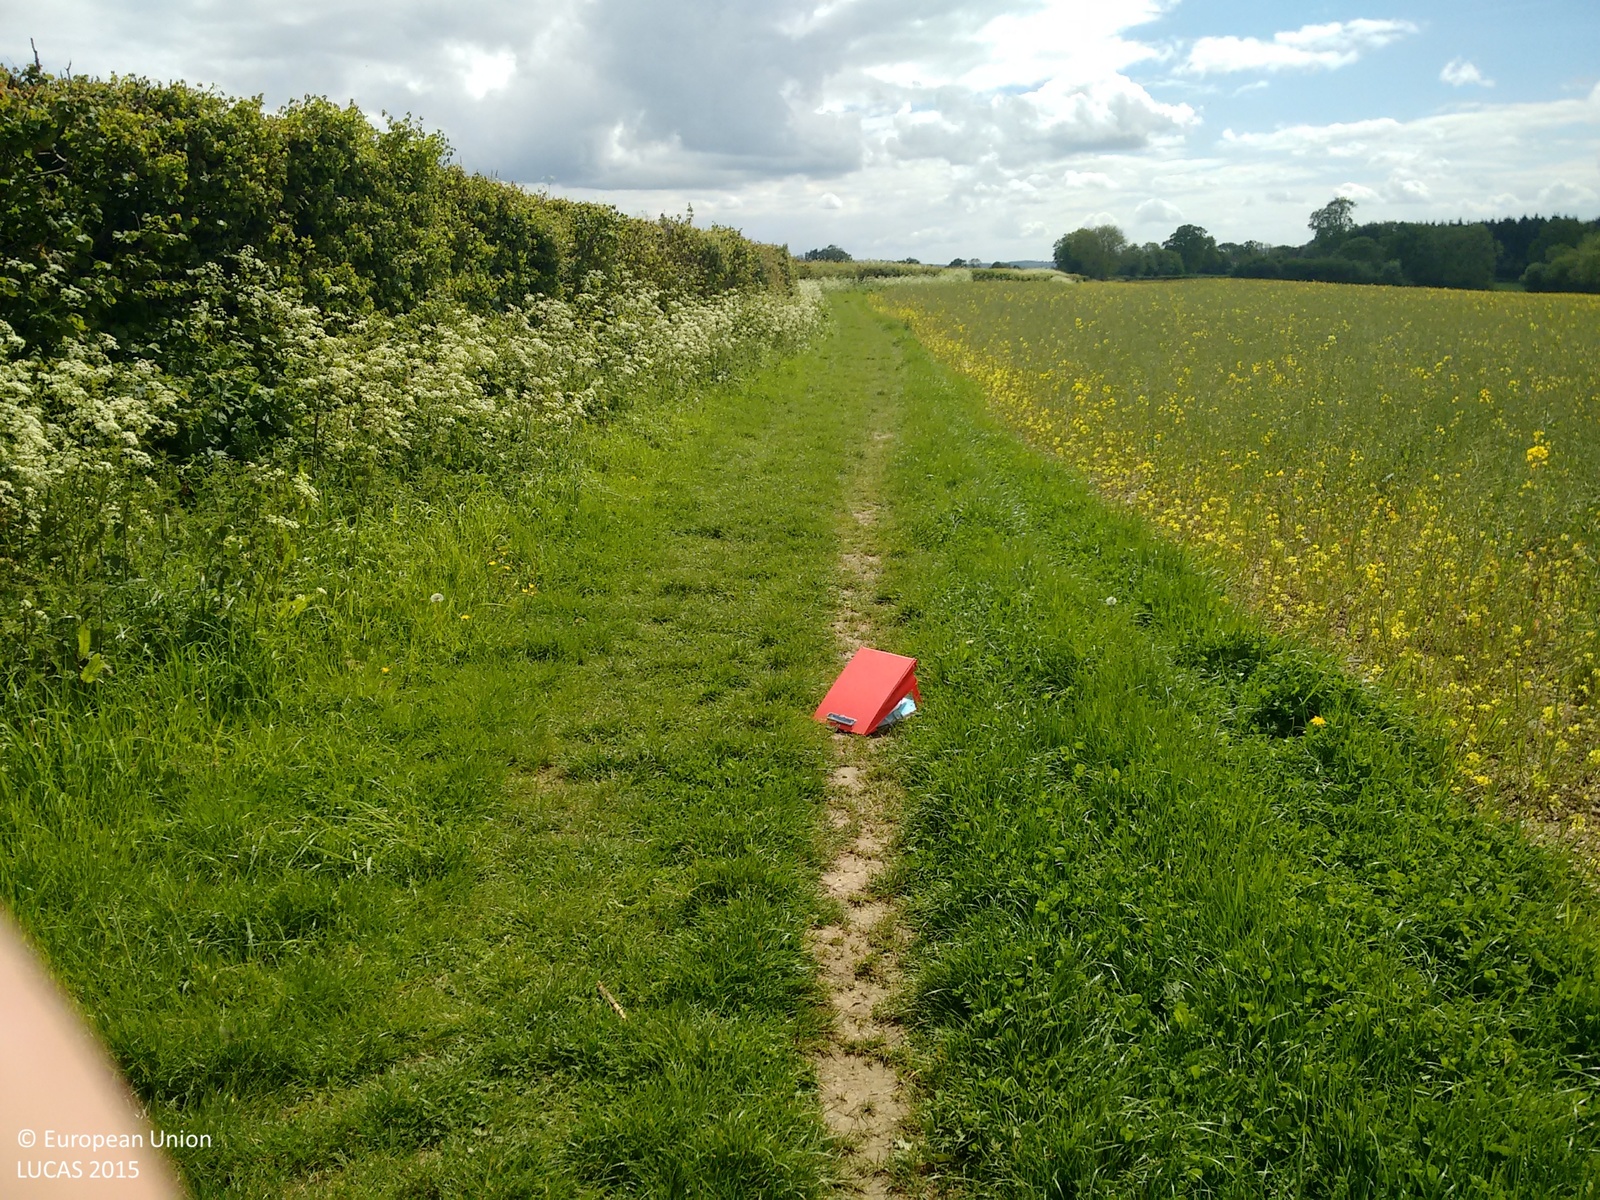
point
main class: Cropland
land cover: Rape and turnip rape
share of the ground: > 75 %
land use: Agriculture (excluding fallow land and kitchen gardens)
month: May
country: GB
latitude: 51.1361
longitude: 0.1792
